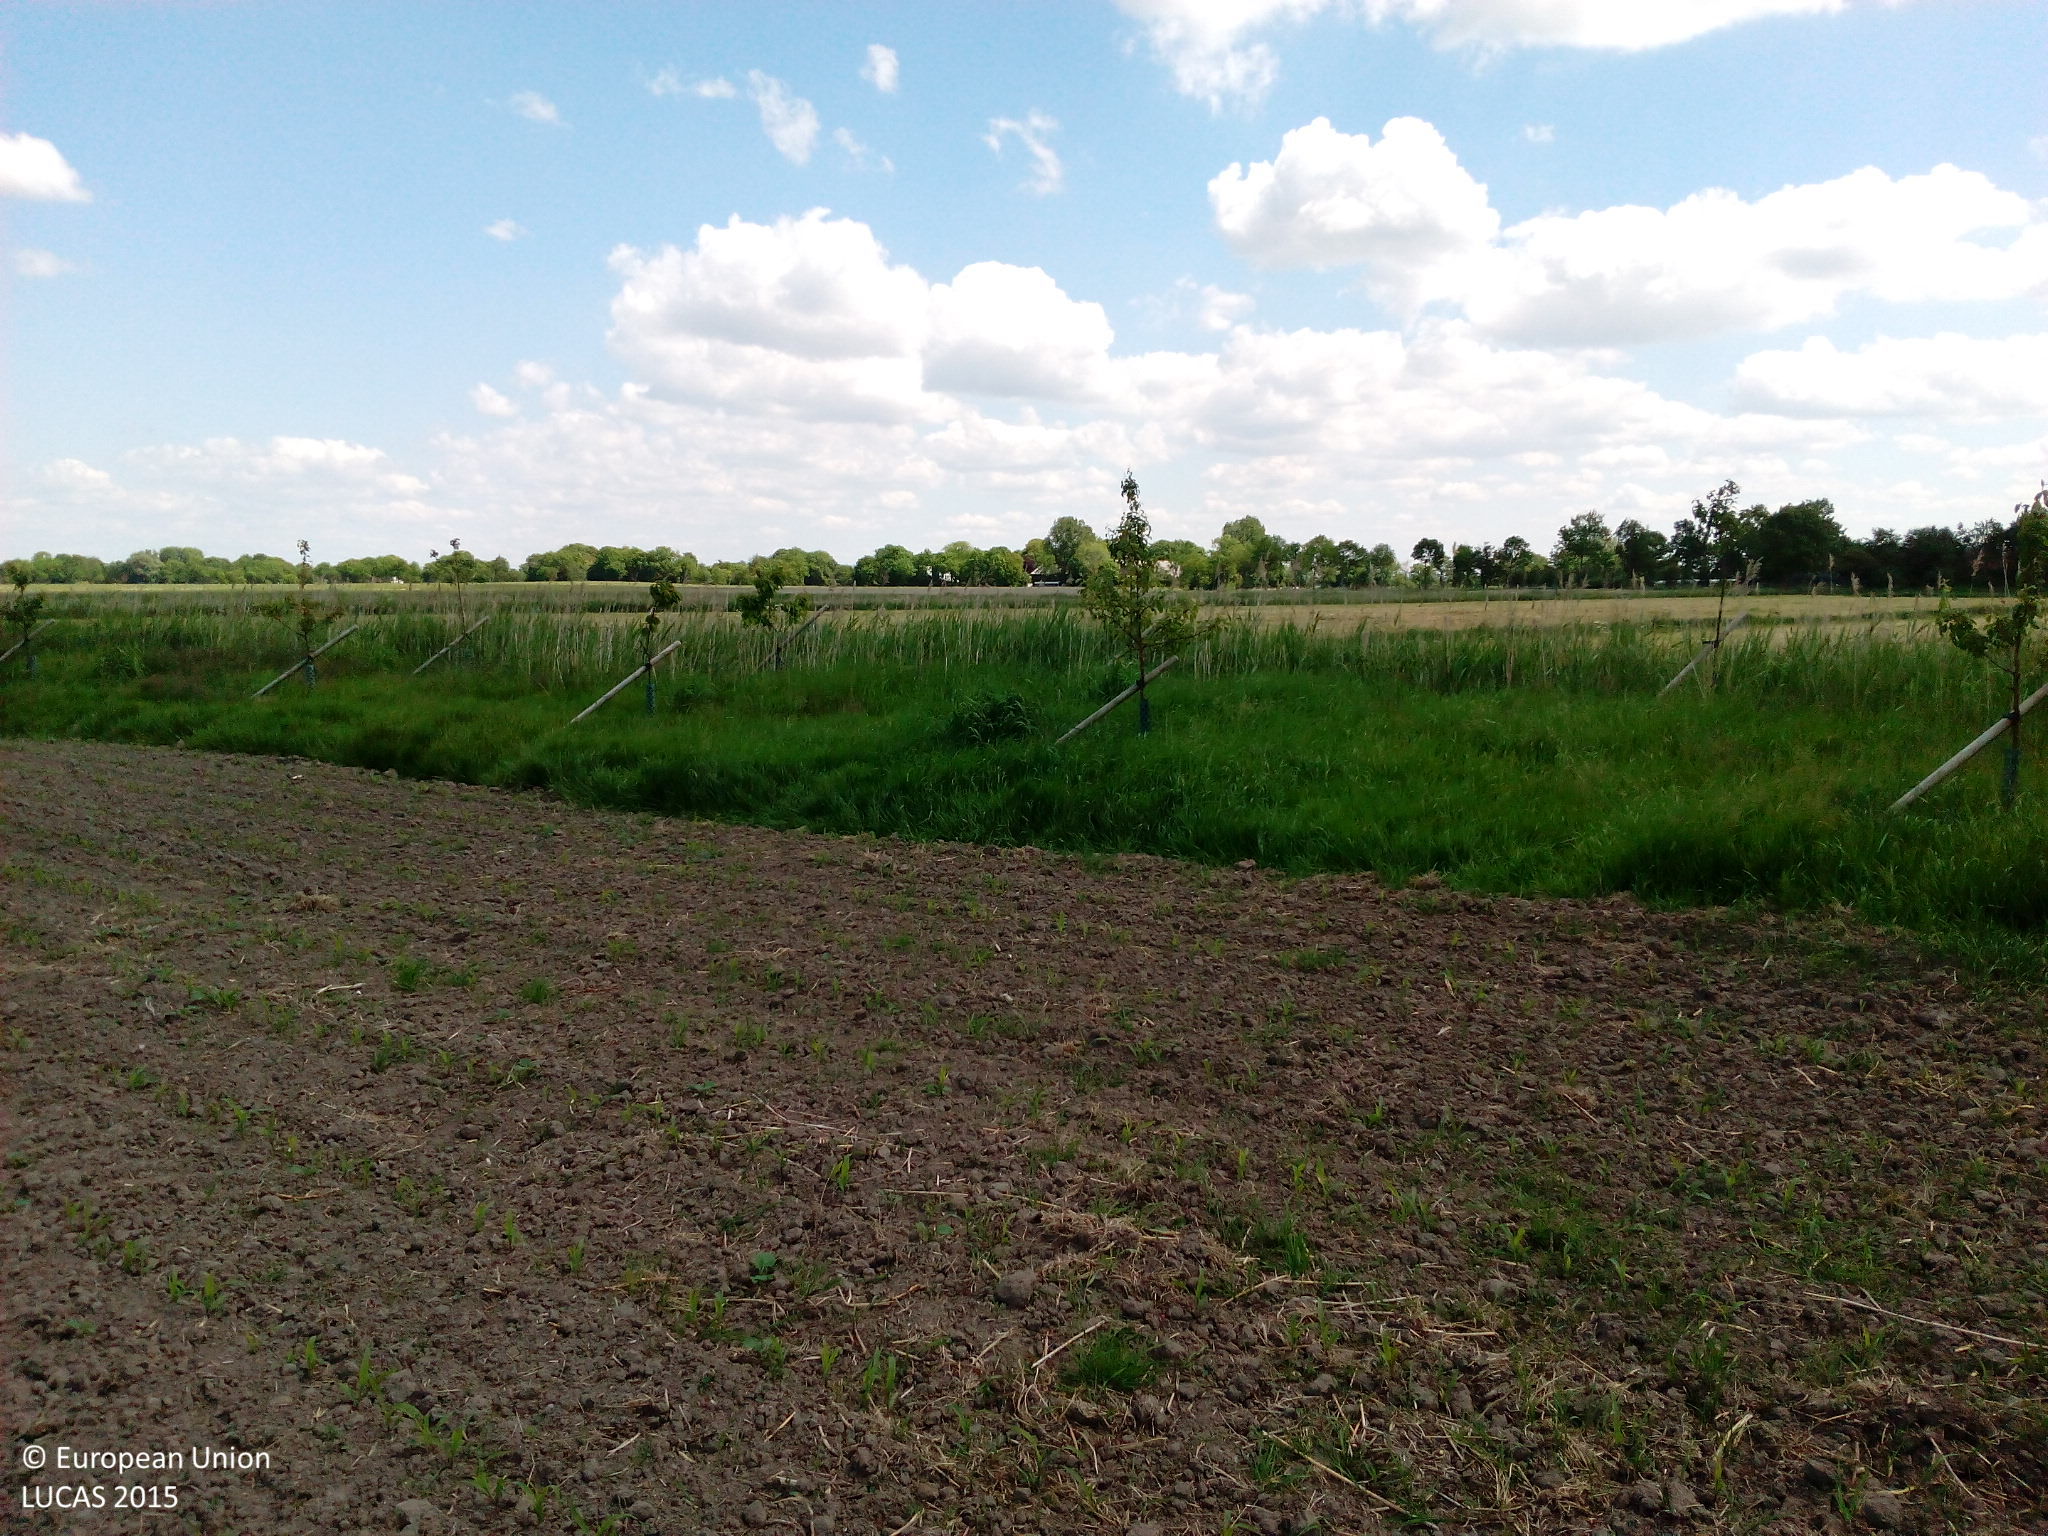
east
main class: Cropland
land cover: Maize
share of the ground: < 10 %
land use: Agriculture (excluding fallow land and kitchen gardens)
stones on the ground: < 10 %
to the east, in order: Maize; Grass margins; Lines of trees; Grassland without tree/shrub cover; Ditches and canals; Fences; Grassland without tree/shrub cover; Fences; Ditches and canals; Grass margins; Paved roads, cycling and walking lanes; Grass margins; Ditches and canals; Grassland without tree/shrub cover; Fences; Ditches and canals; Grass margins; Common wheat; Grass margins; Ditches and canals; Spontaneously vegetated surfaces
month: June
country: DE
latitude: 53.7166
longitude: 8.5309
